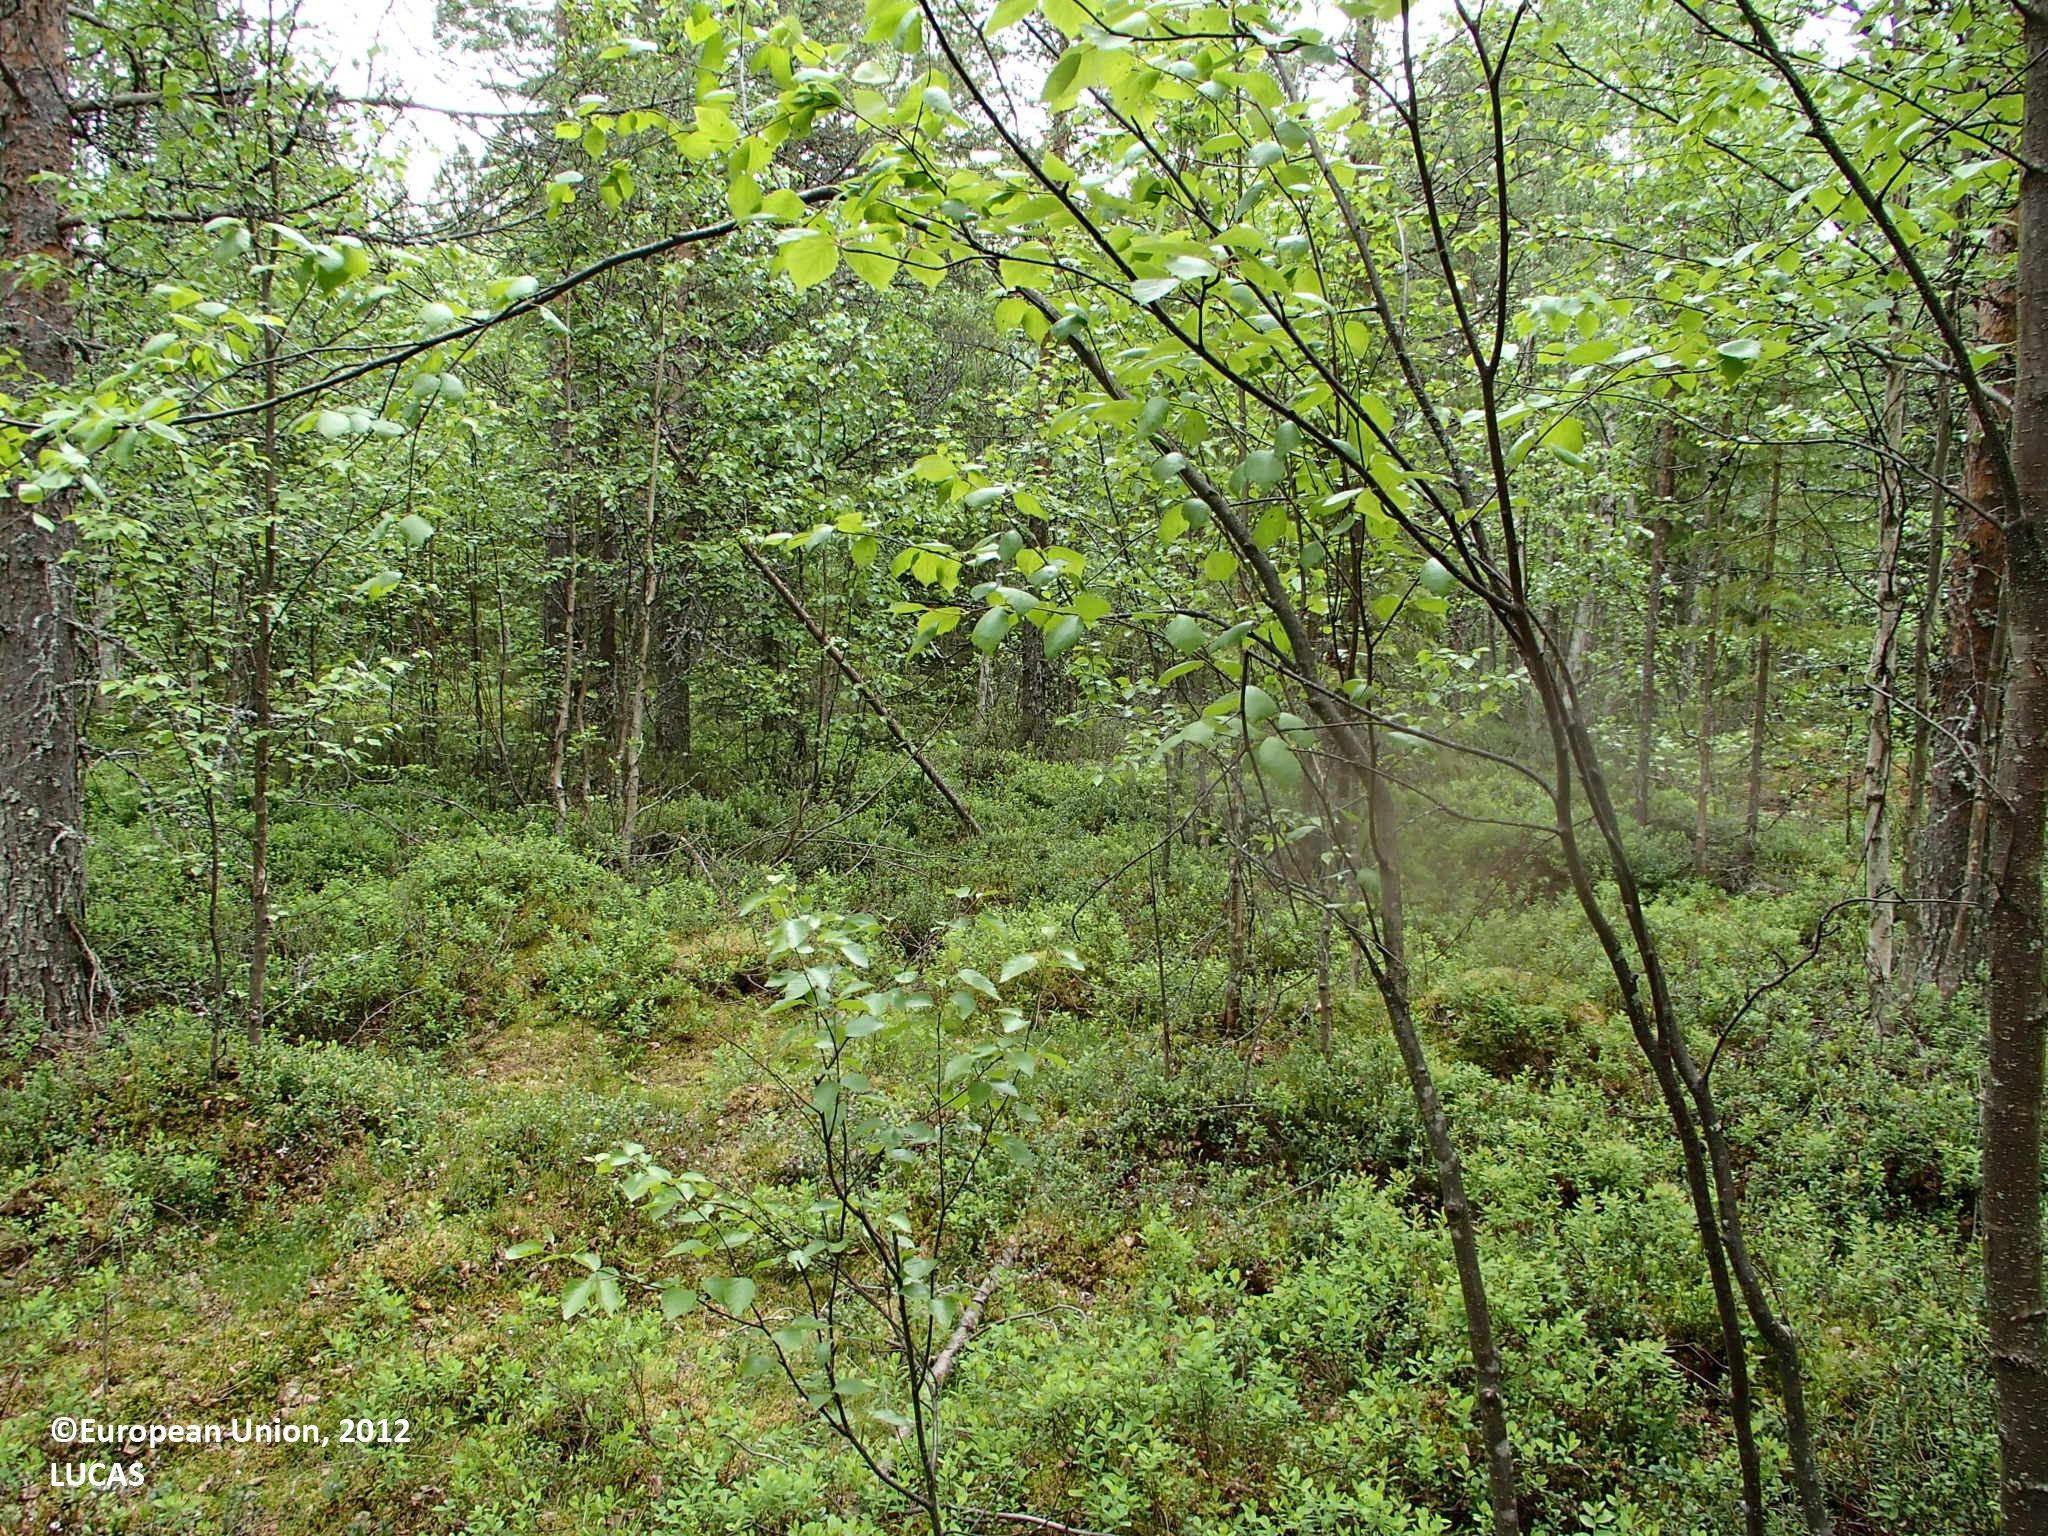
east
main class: Woodland
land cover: Pine dominated coniferous woodland
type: boreal forest
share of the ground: > 75 %
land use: Forestry
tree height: > 5 m
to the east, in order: Pine dominated coniferous woodland; Ditches and canals; Pine dominated mixed woodland; Pine dominated coniferous woodland; Other bare soil; Pine dominated mixed woodland; Sand
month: June
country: FI
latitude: 66.7870
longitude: 27.5027
